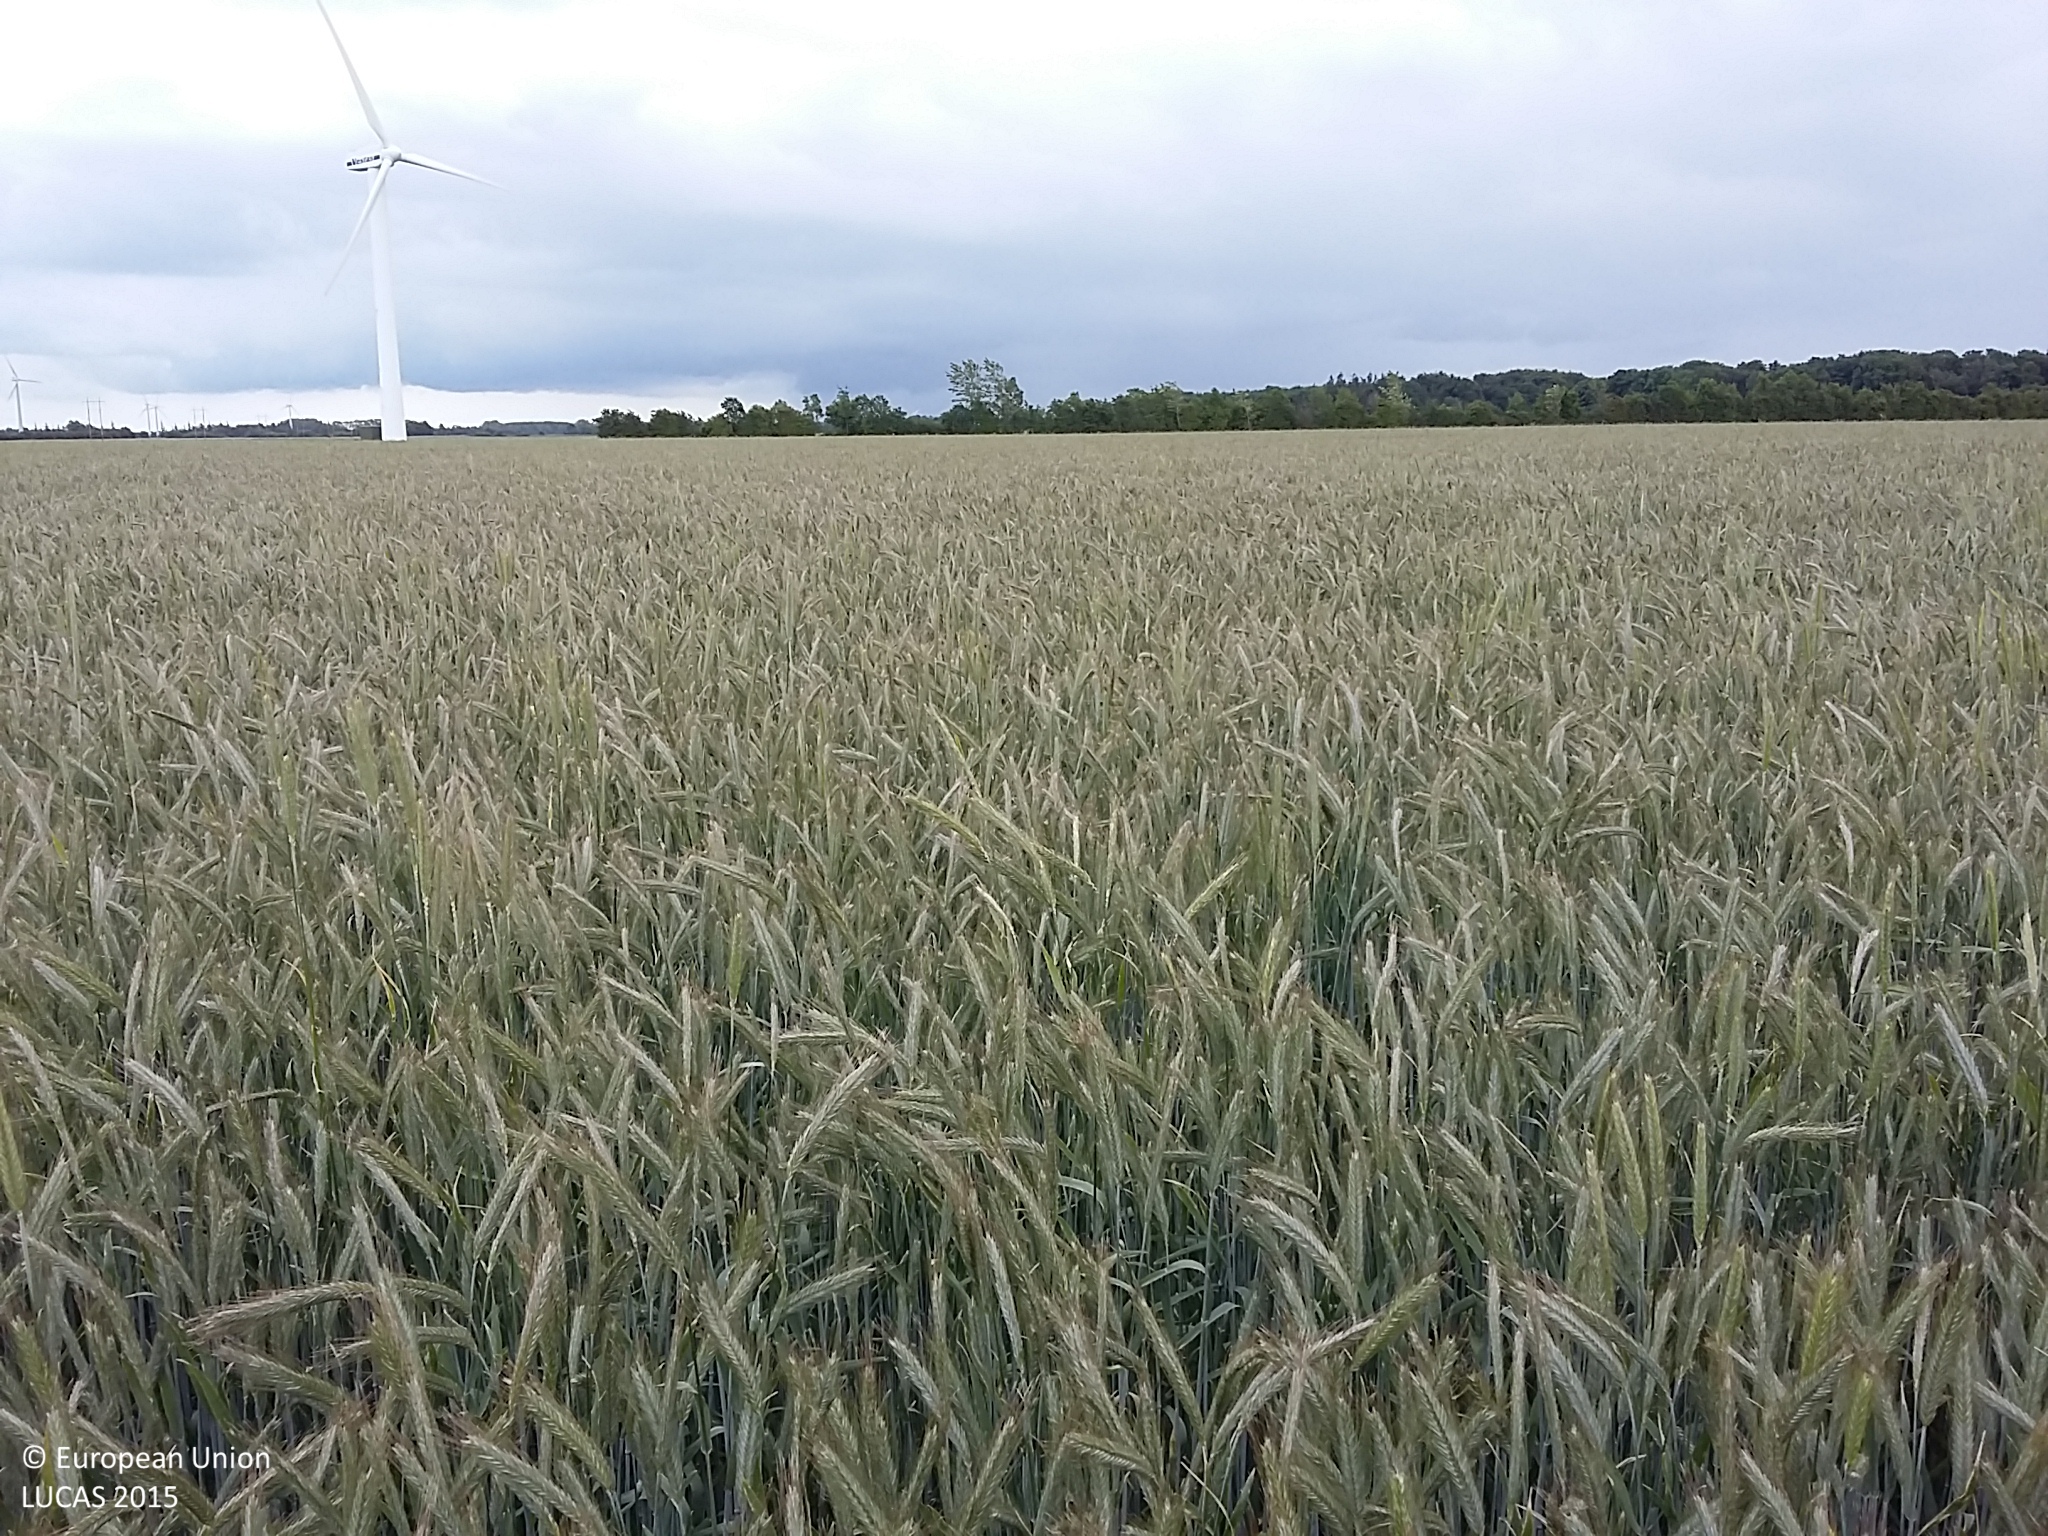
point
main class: Cropland
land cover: Rye
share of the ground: > 75 %
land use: Agriculture (excluding fallow land and kitchen gardens)
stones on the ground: < 10 %
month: June
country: DK
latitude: 54.7435
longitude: 11.2574
